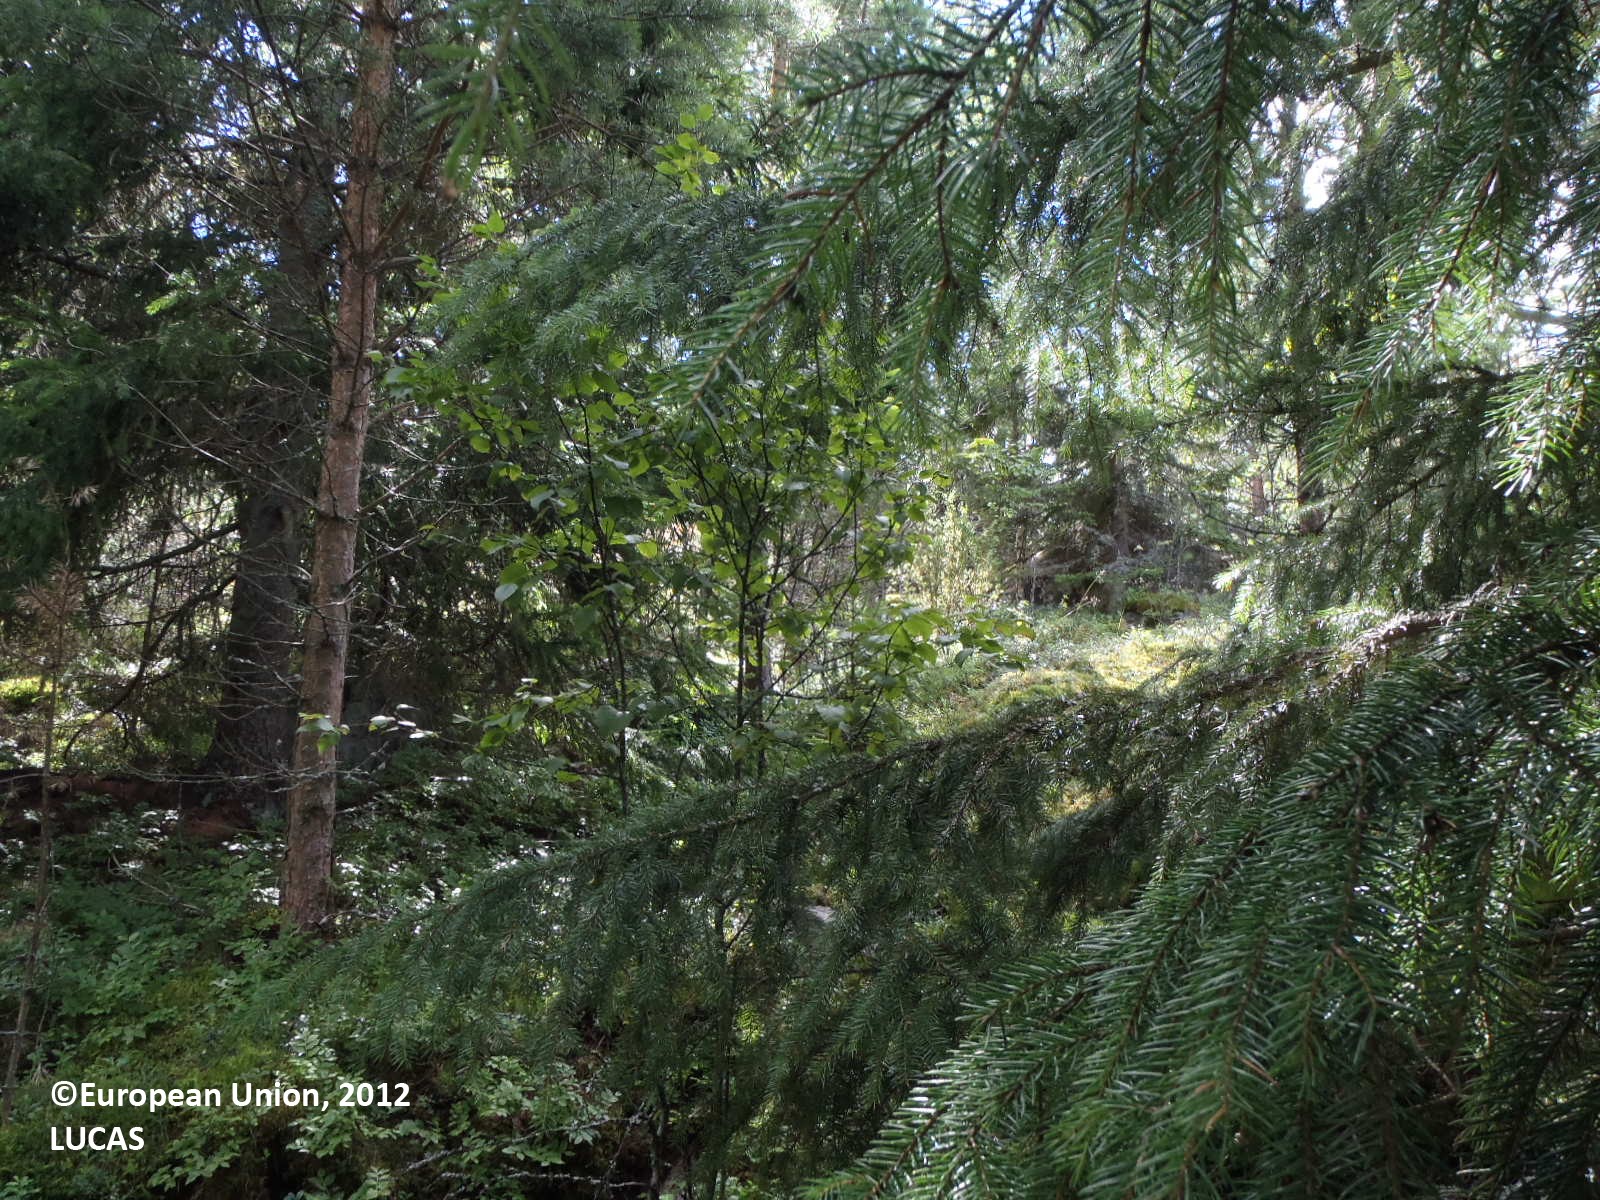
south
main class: Woodland
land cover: Spruce dominated mixed woodland
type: boreal forest
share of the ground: > 75 %
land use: Forestry
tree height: > 5 m
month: August
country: FI
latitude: 60.1224
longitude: 21.9972
